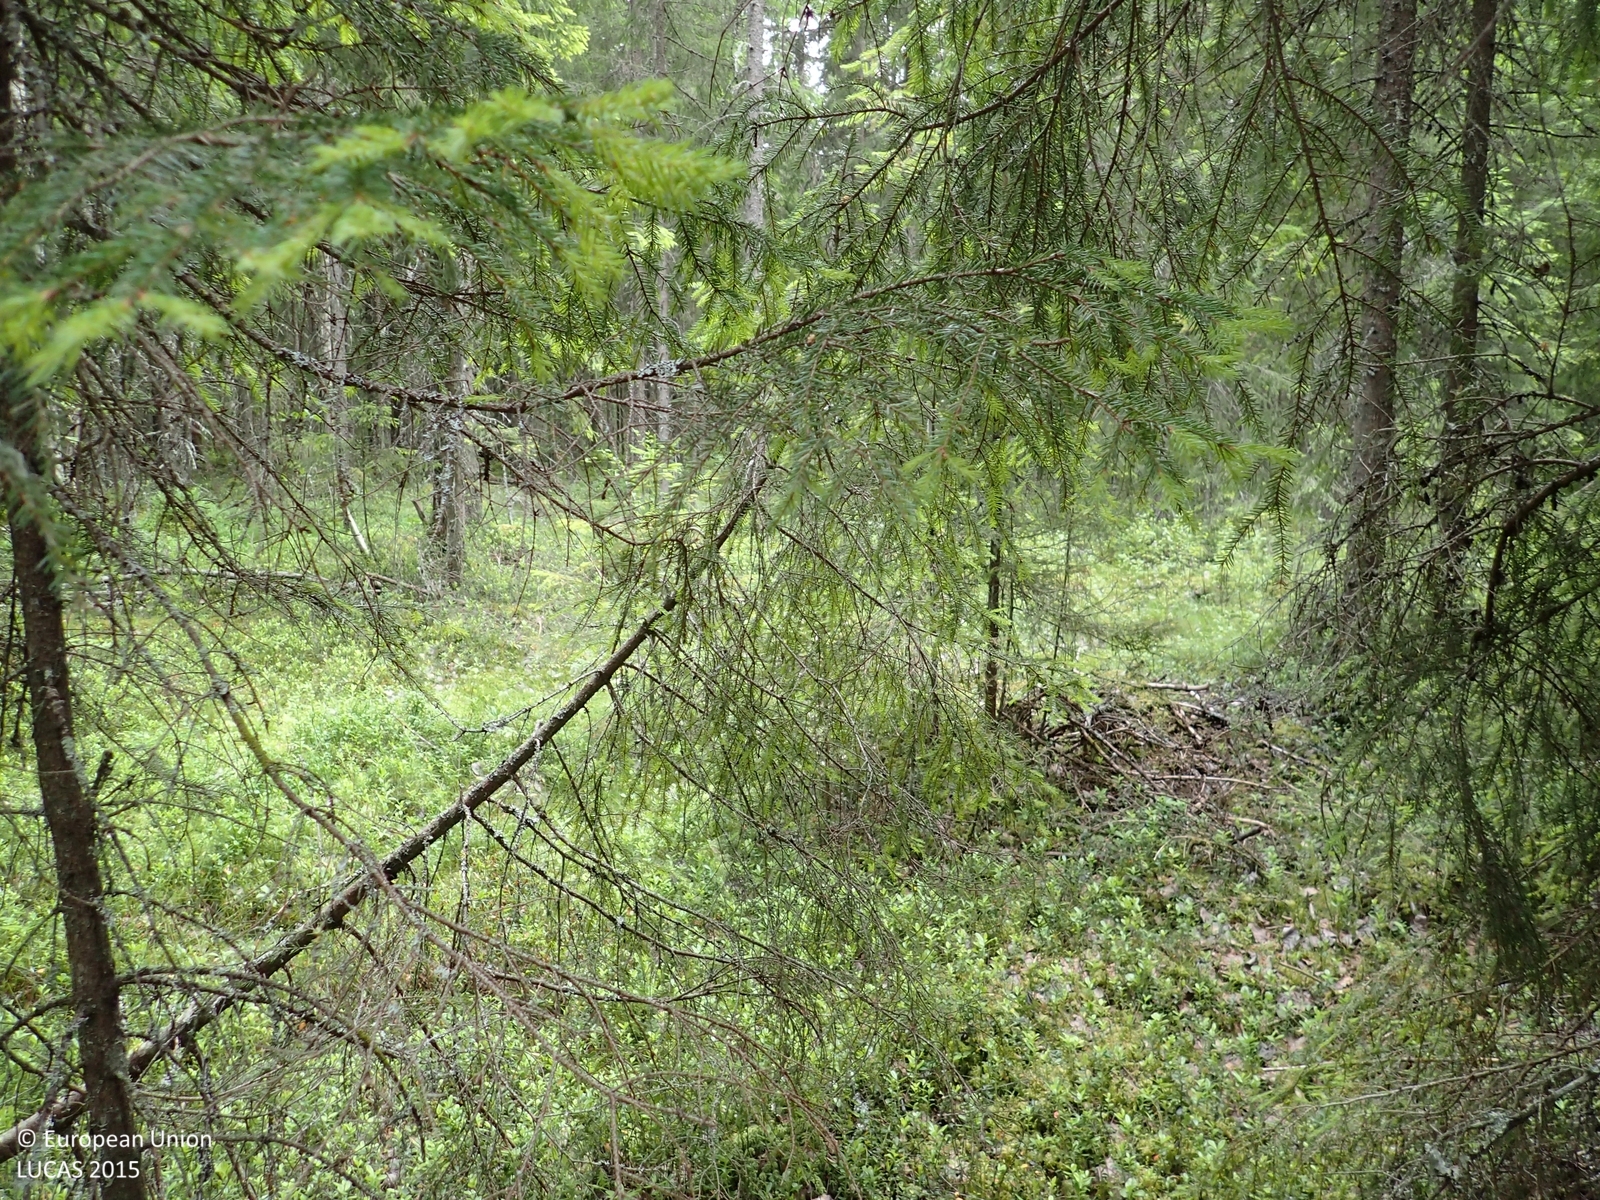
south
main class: Woodland
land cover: Spruce dominated coniferous woodland
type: boreal forest
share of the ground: > 75 %
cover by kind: coniferous forest trees 80 %, shrubs 10 %, broadleaved forest trees 5 %, lichens and mosses 5 %
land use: Forestry
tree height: > 5 m
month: July
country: FI
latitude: 62.7518
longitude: 21.7715
